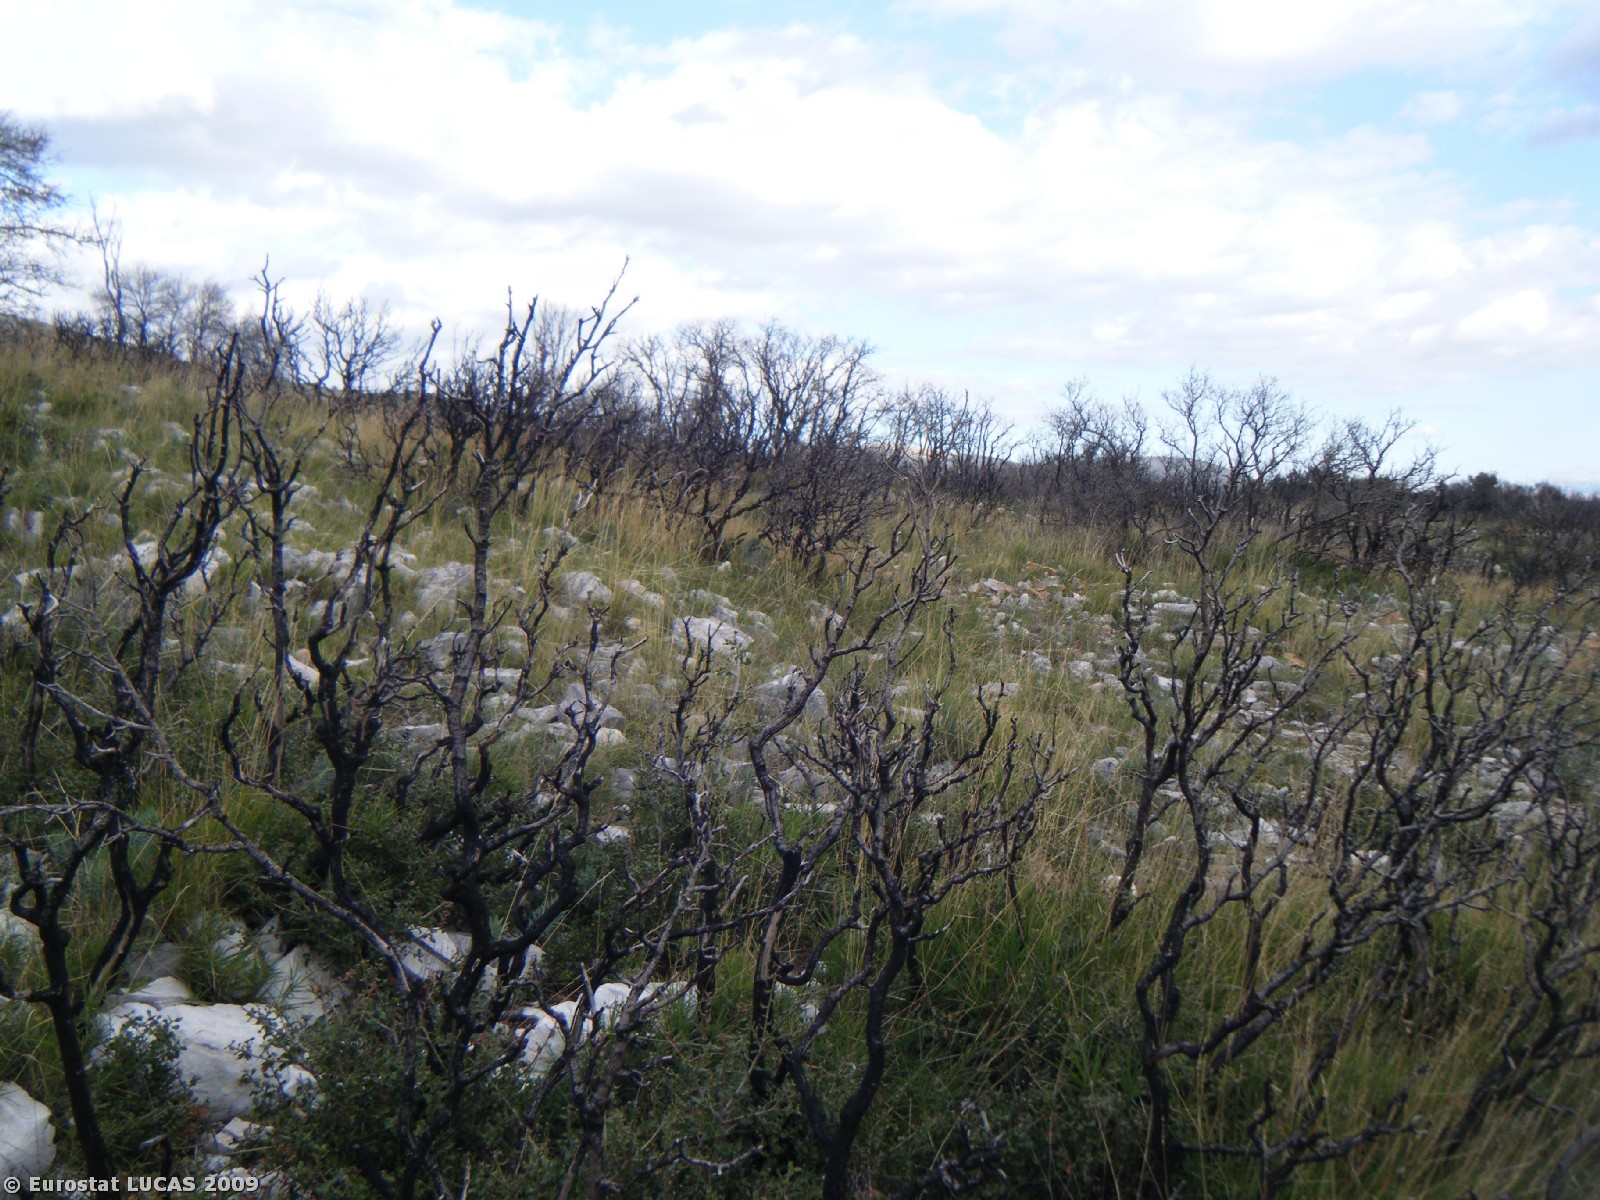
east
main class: Grassland
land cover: Grassland with sparse tree/shrub cover
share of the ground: 50 - 75 %
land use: Unused
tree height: < 5 m
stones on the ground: 25 - 50 %
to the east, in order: Grassland with sparse tree/shrub cover; Tracks; Grassland with sparse tree/shrub cover
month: October
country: GR
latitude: 37.4682
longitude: 22.2281
